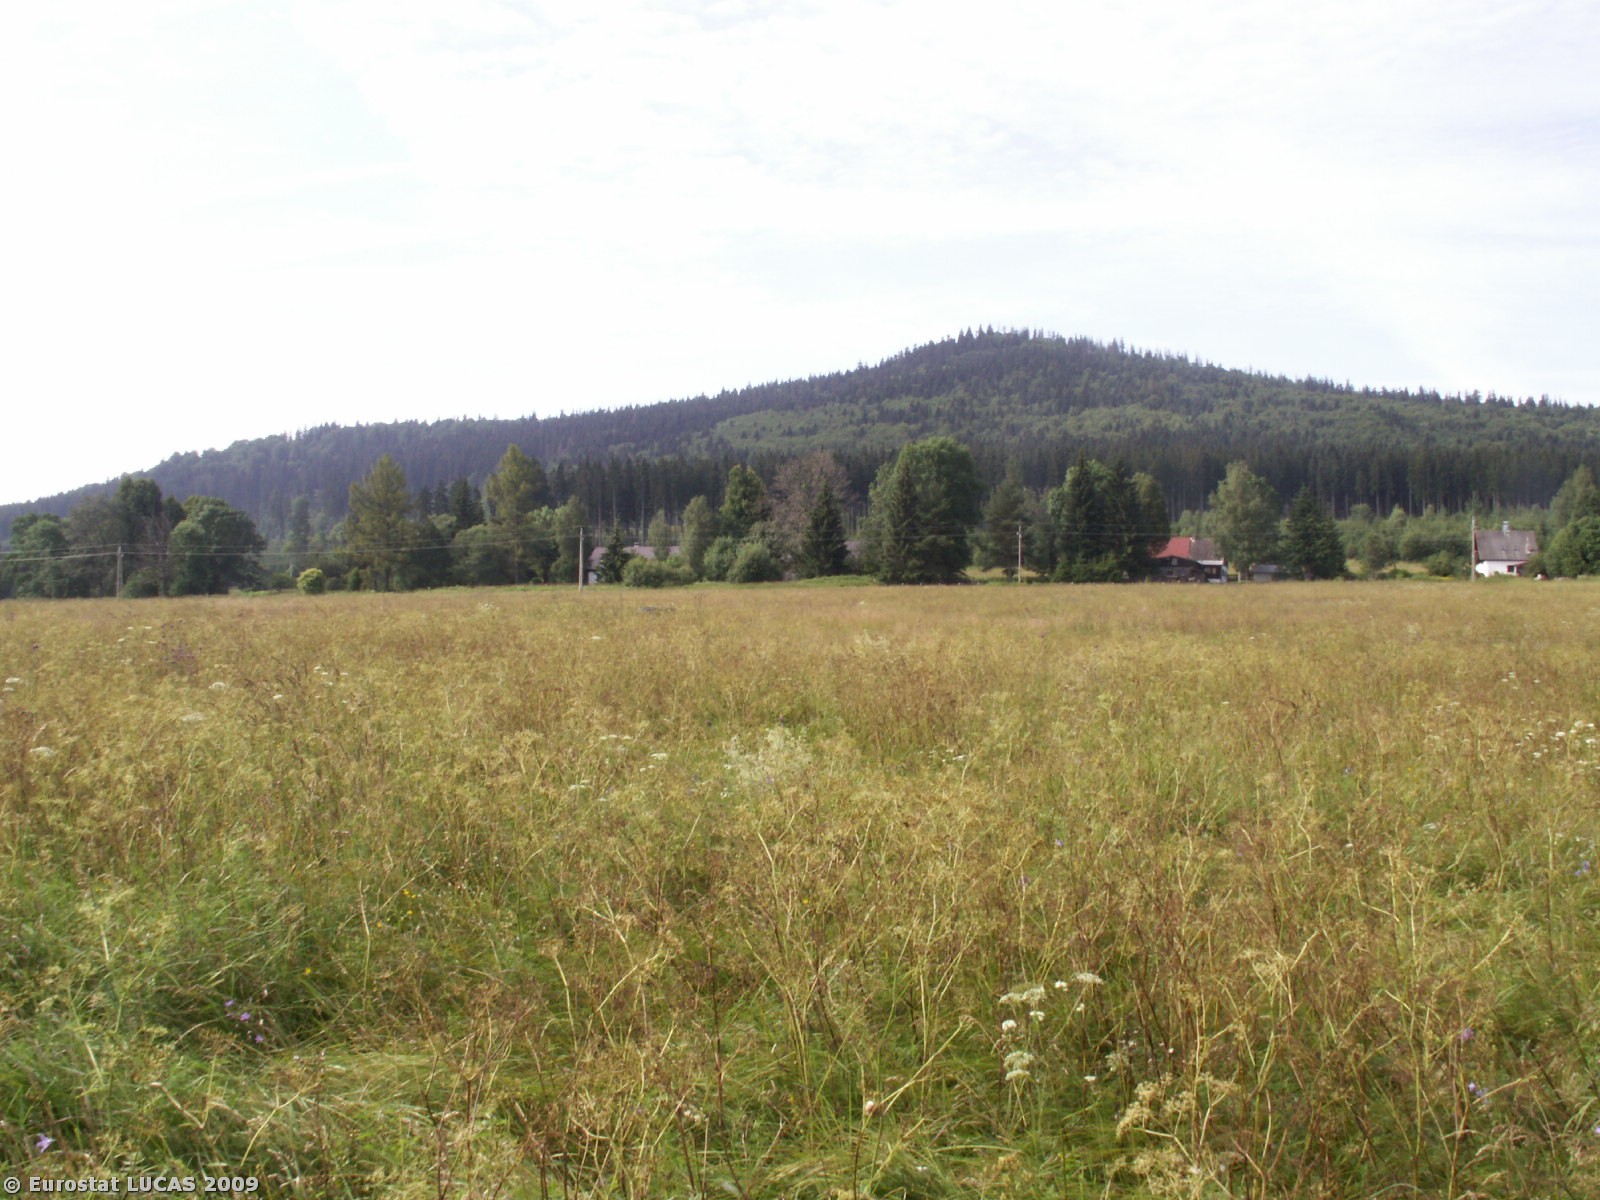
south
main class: Grassland
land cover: Grassland without tree/shrub cover
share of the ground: > 75 %
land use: Fallow land
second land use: Nature reserves
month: July
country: CZ
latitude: 48.8954
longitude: 13.8331
